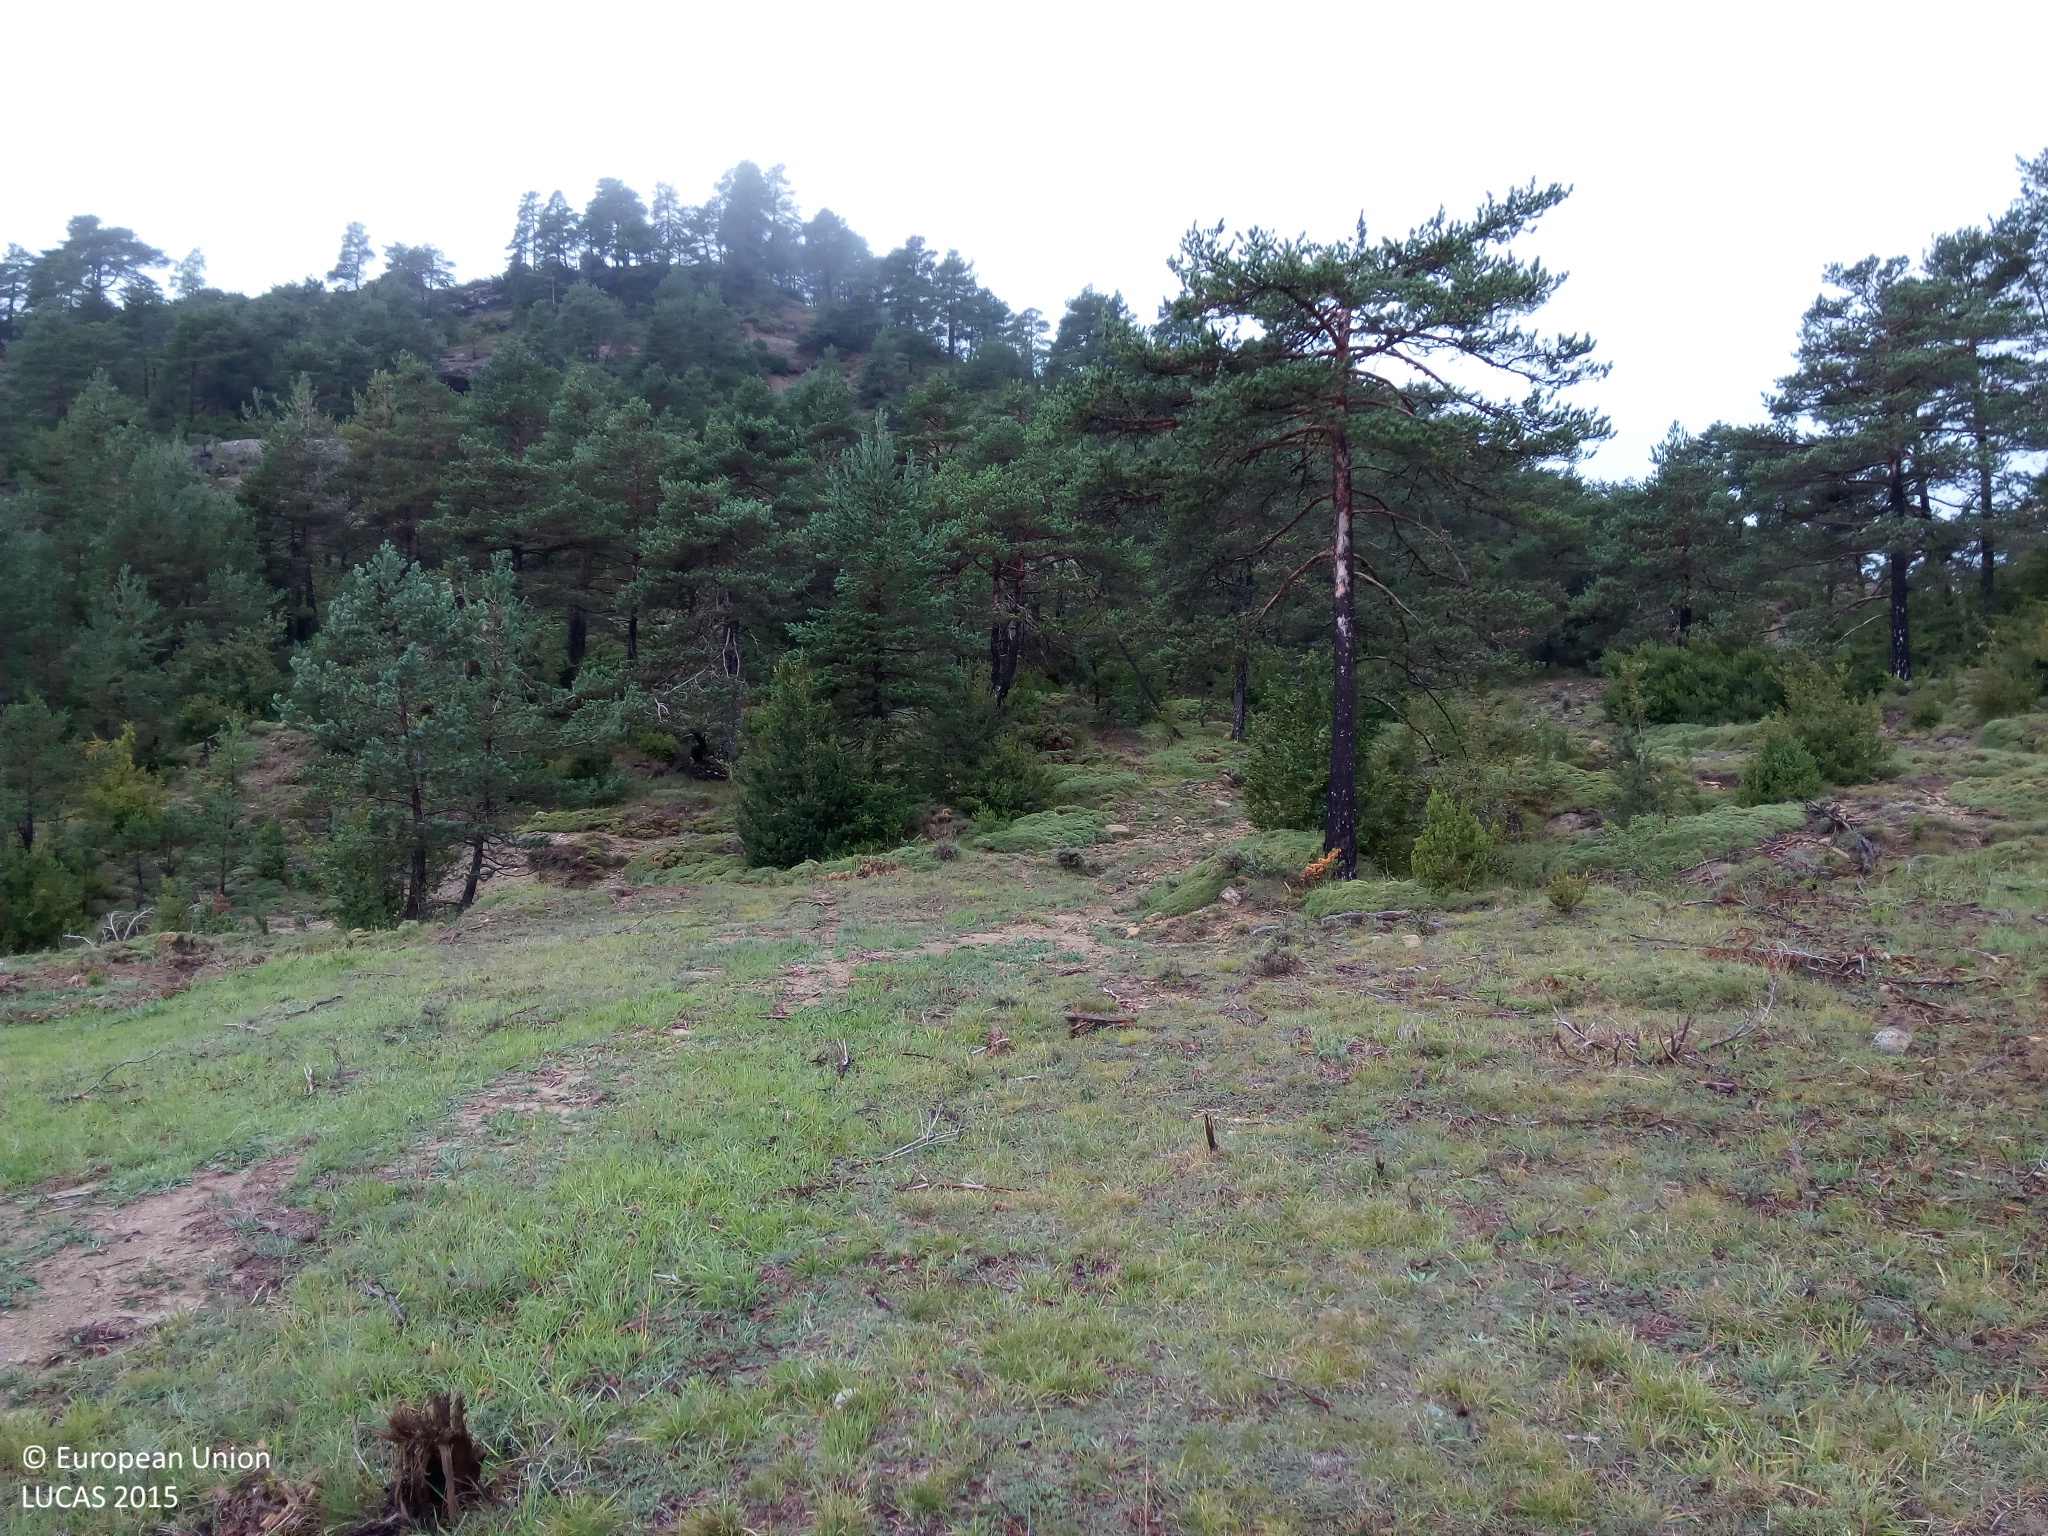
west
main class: Grassland
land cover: Grassland without tree/shrub cover
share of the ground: > 75 %
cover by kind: herbaceous plants 100 %
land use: Forestry
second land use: Agriculture (excluding fallow land and kitchen gardens)
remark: Clear cut
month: September
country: ES
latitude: 42.4055
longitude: -0.0707
